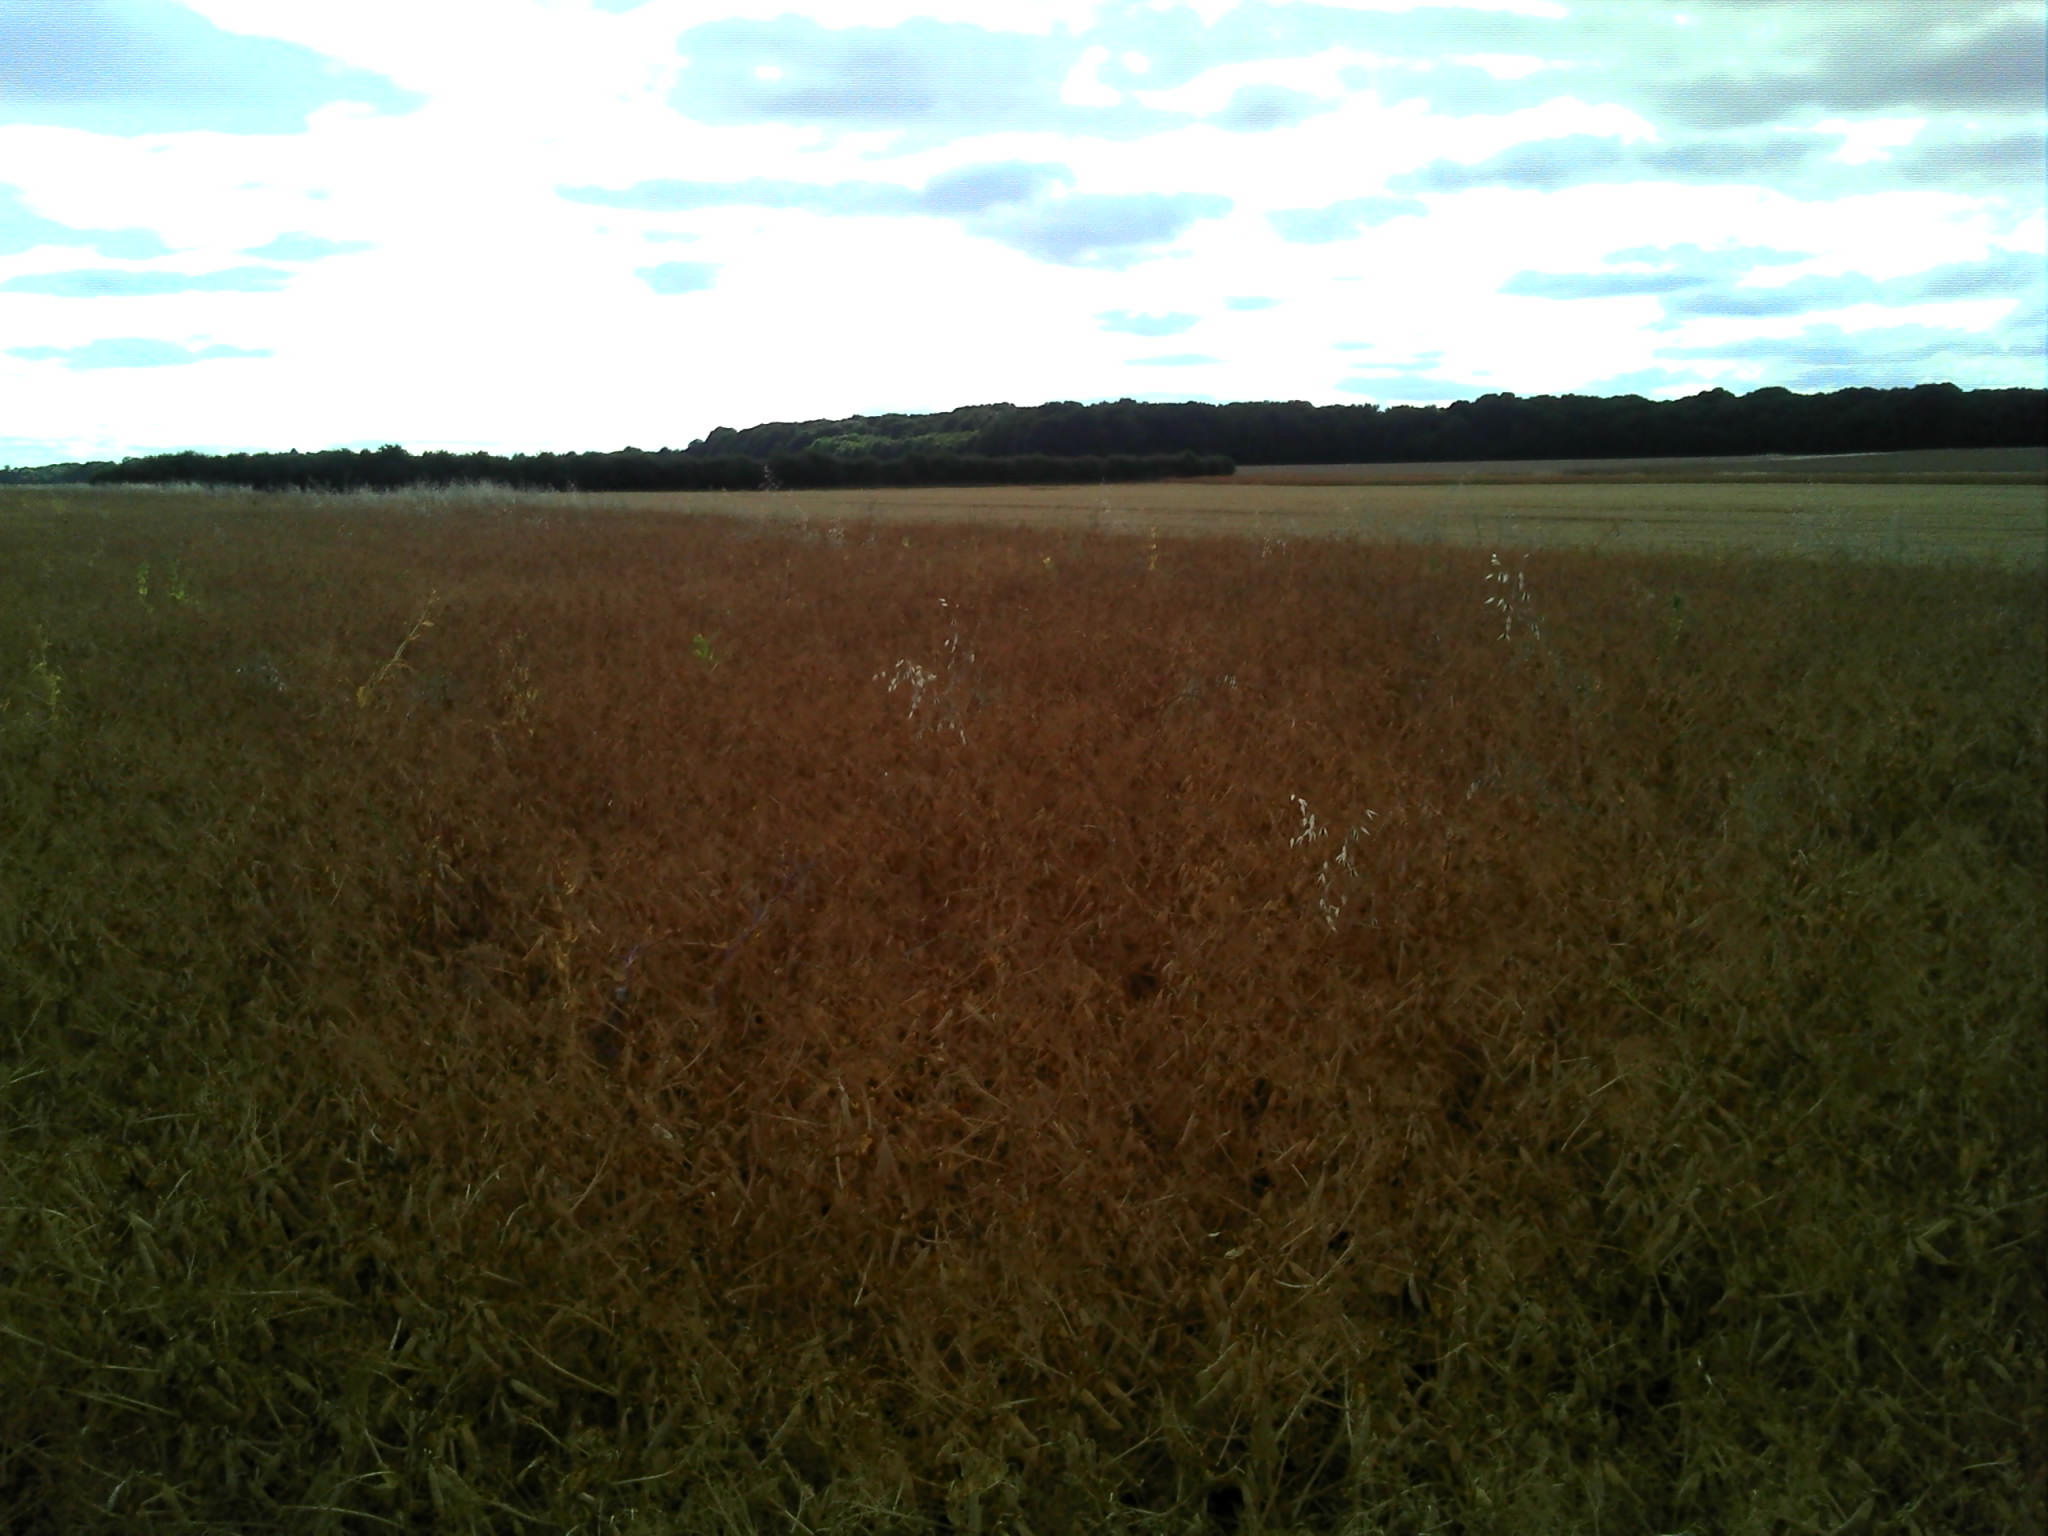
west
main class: Cropland
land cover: Dry pulses
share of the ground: > 75 %
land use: Agriculture (excluding fallow land and kitchen gardens)
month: July
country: FR
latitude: 48.6876
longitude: 0.7808
